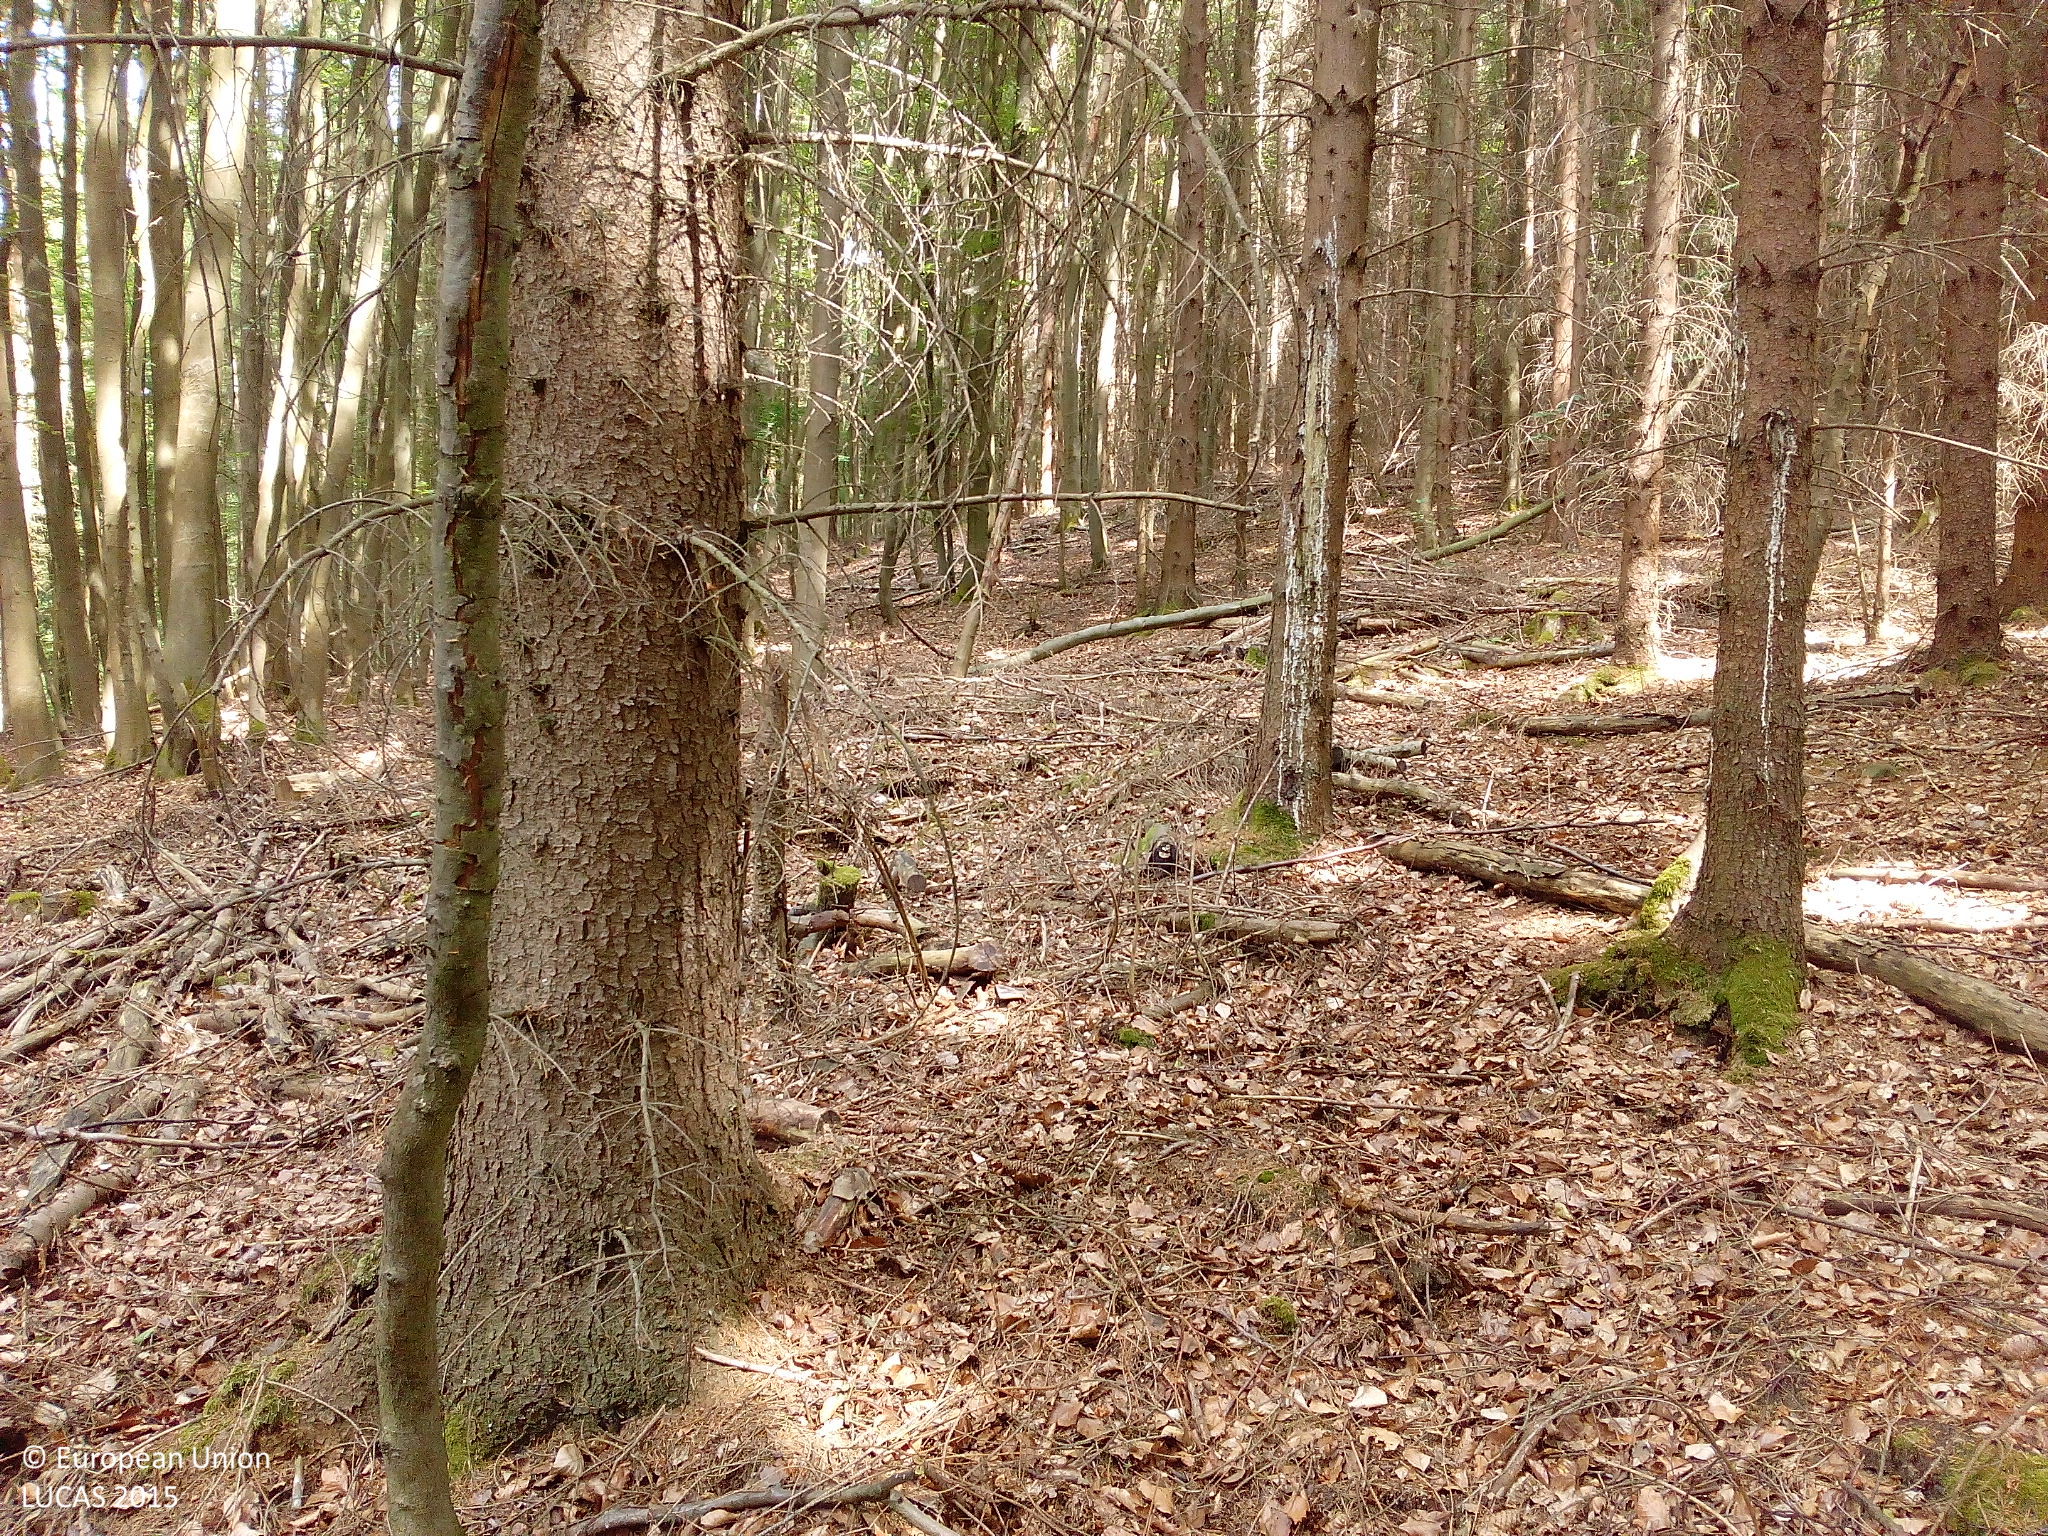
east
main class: Woodland
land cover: Spruce dominated mixed woodland
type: hemiboreal forest and nemoral coniferous forest and mixed broadleaved-coniferous forest
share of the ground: > 75 %
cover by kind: broadleaved forest trees 55 %, coniferous forest trees 45 %
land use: Forestry
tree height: > 5 m
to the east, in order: Spruce dominated mixed woodland; Broadleaved woodland; Tracks; Spruce dominated coniferous woodland; Tracks
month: June
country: DE
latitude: 50.9015
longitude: 9.3319
